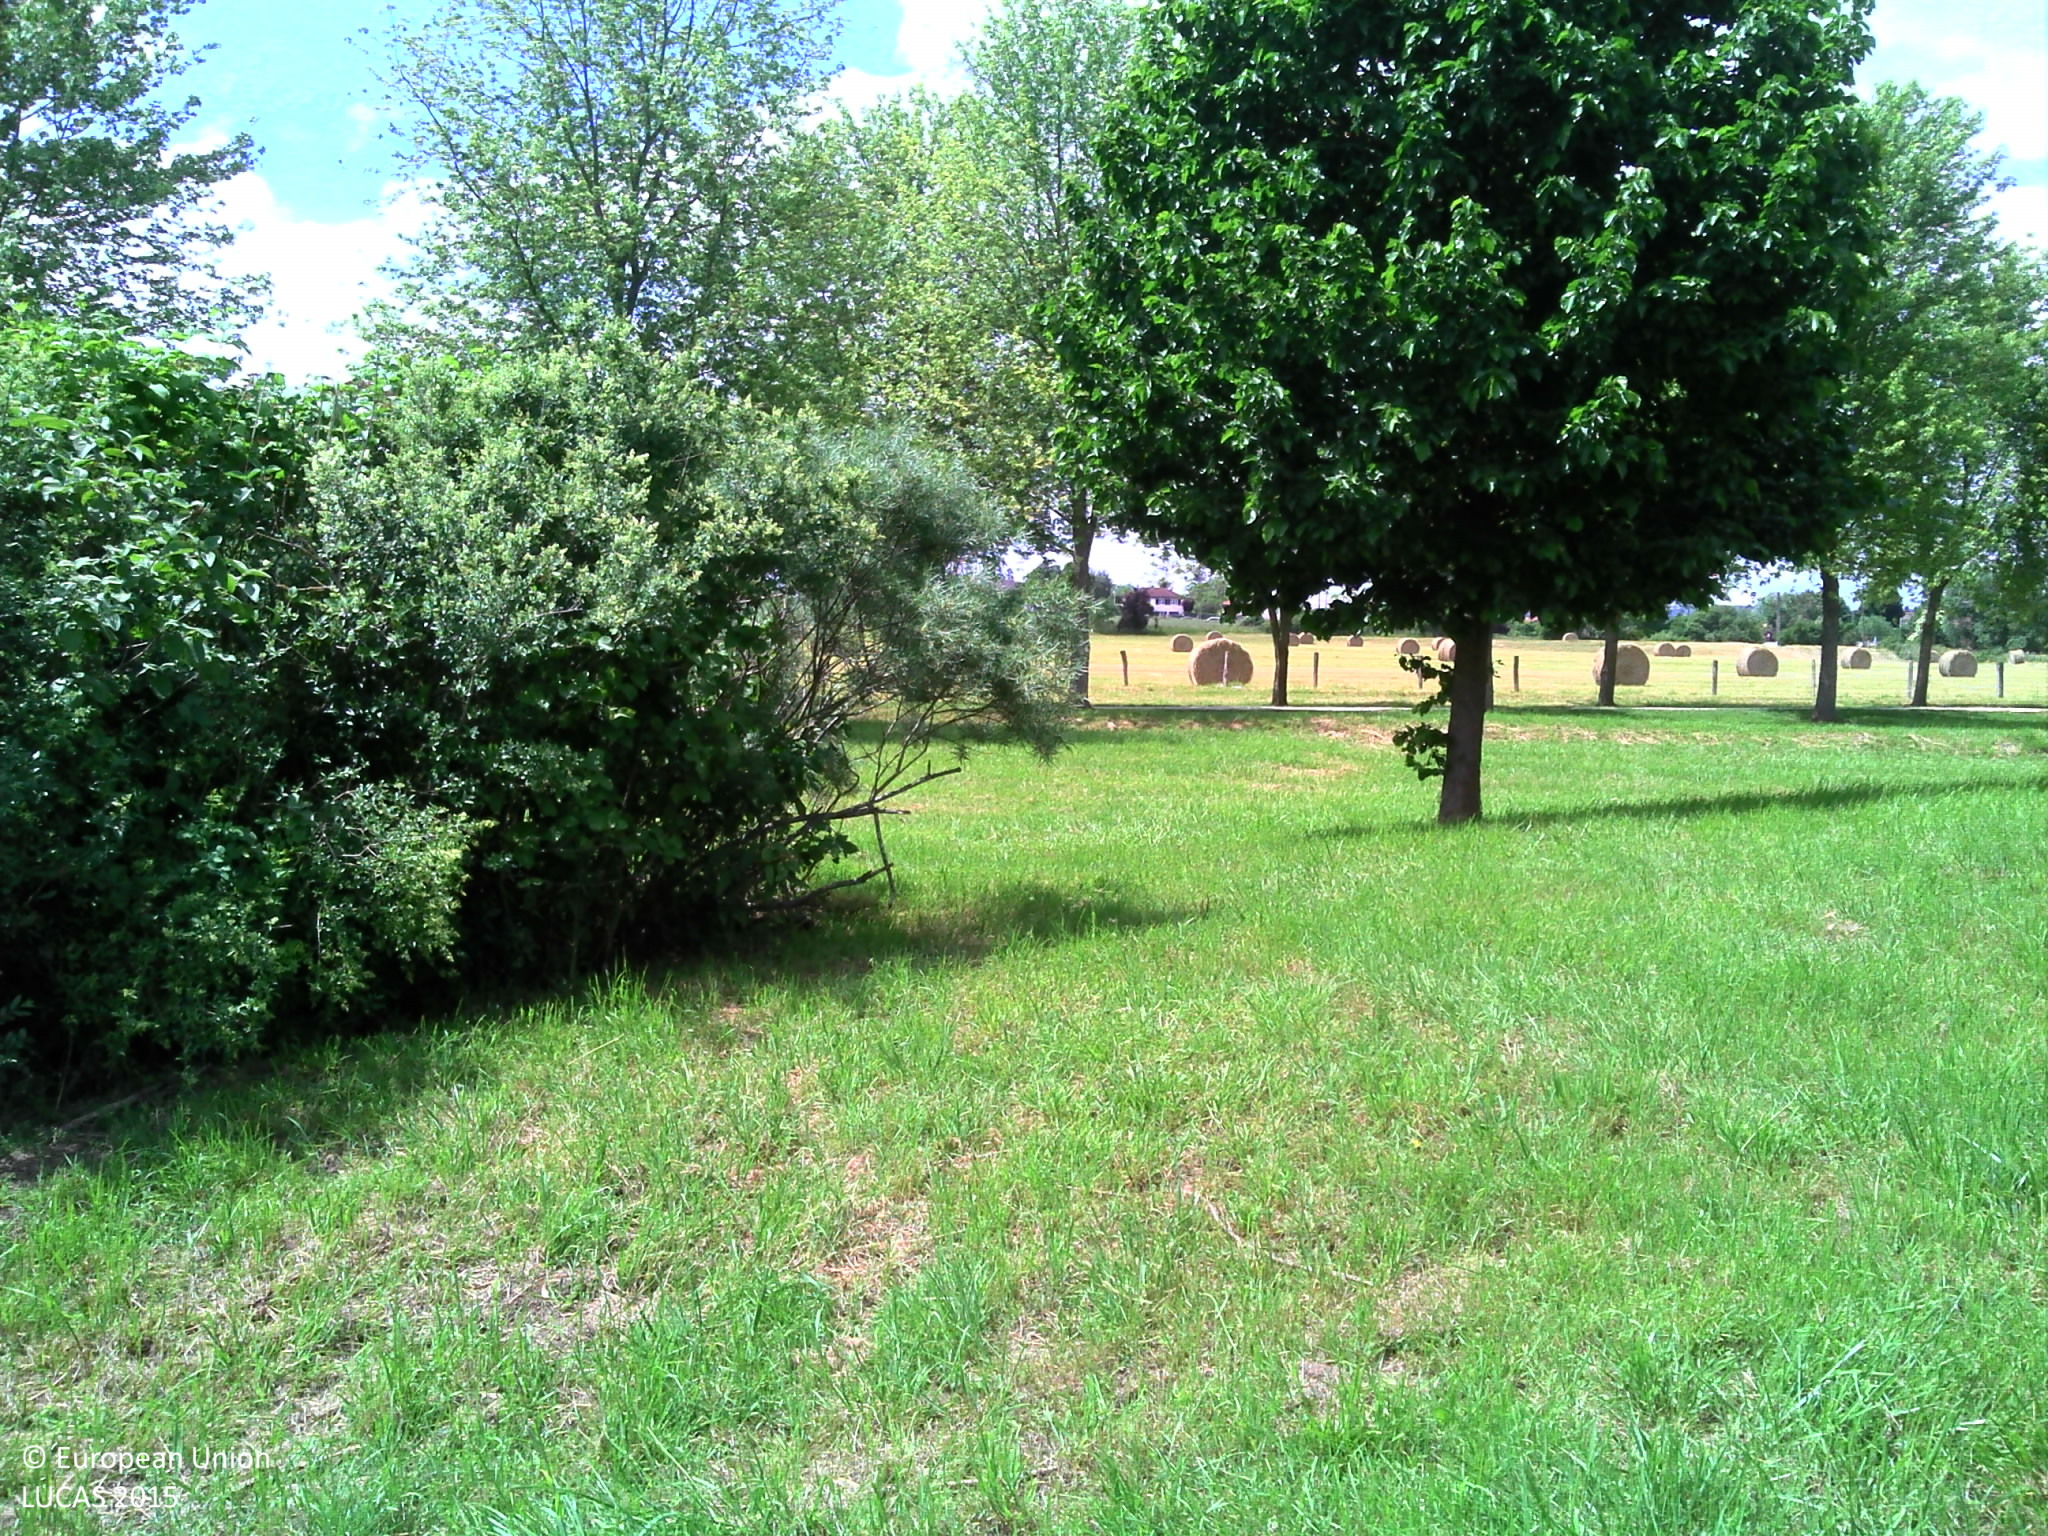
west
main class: Grassland
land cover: Grassland with sparse tree/shrub cover
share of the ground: > 75 %
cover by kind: herbaceous plants 95 %, broadleaved forest trees 5 %
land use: Amenities, museums, leisure
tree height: < 5 m
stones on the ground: < 10 %
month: June
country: FR
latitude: 48.6817
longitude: 6.2378
